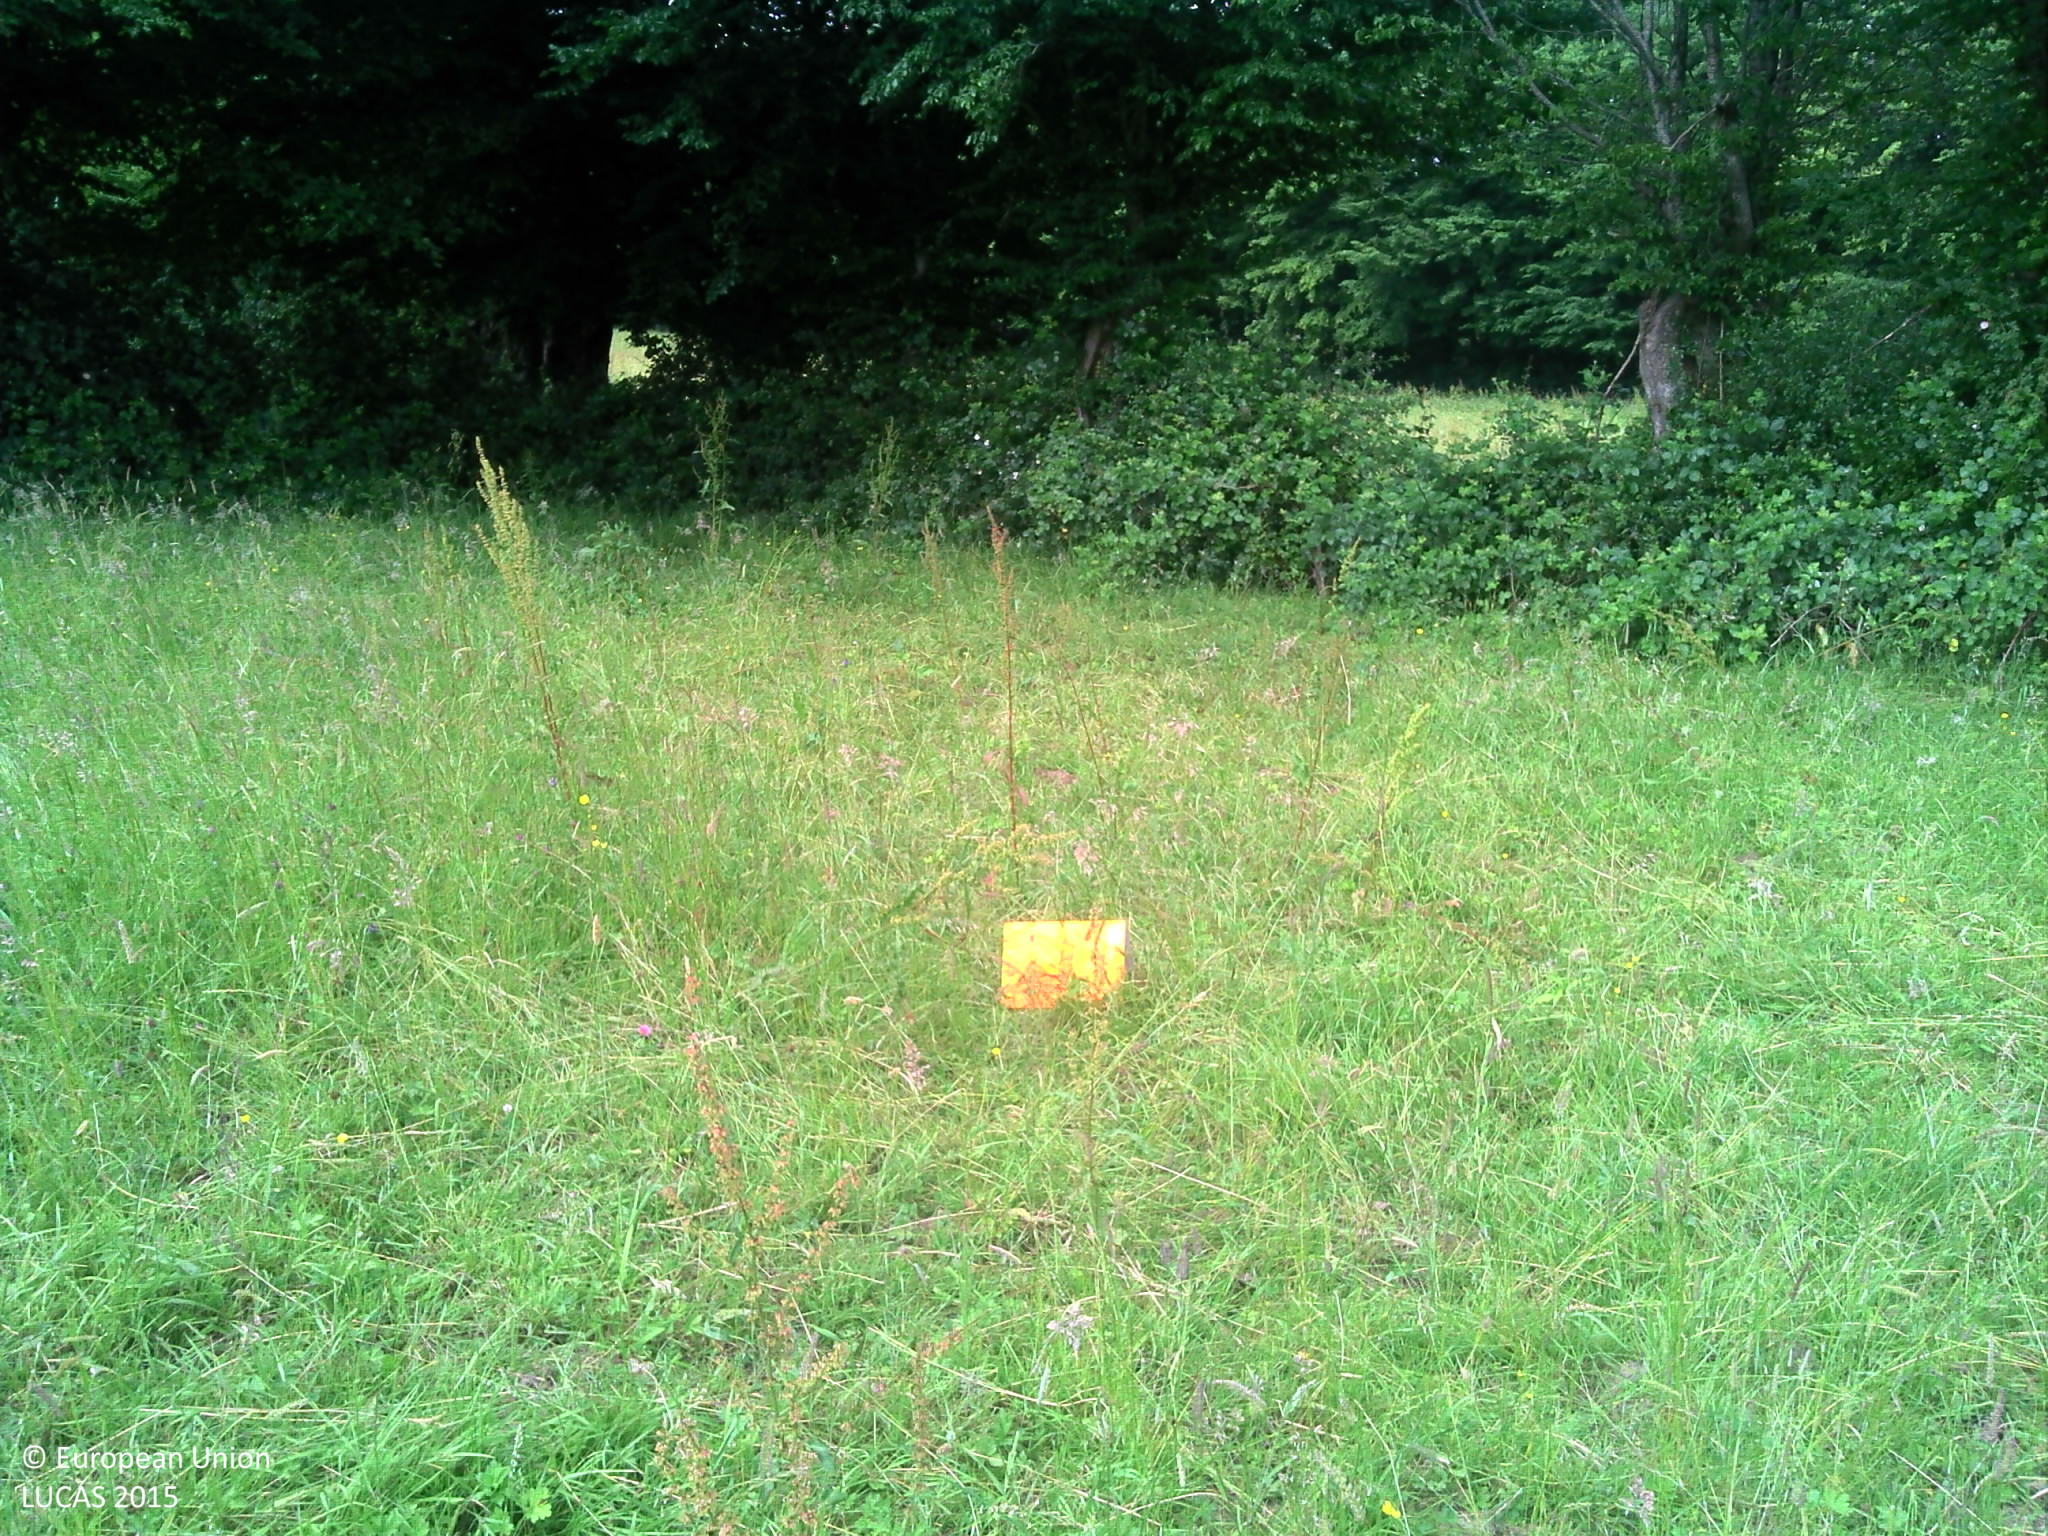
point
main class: Grassland
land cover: Grassland without tree/shrub cover
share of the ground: > 75 %
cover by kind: herbaceous plants 100 %
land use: Agriculture (excluding fallow land and kitchen gardens)
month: June
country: FR
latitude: 49.9176
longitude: 3.9918
